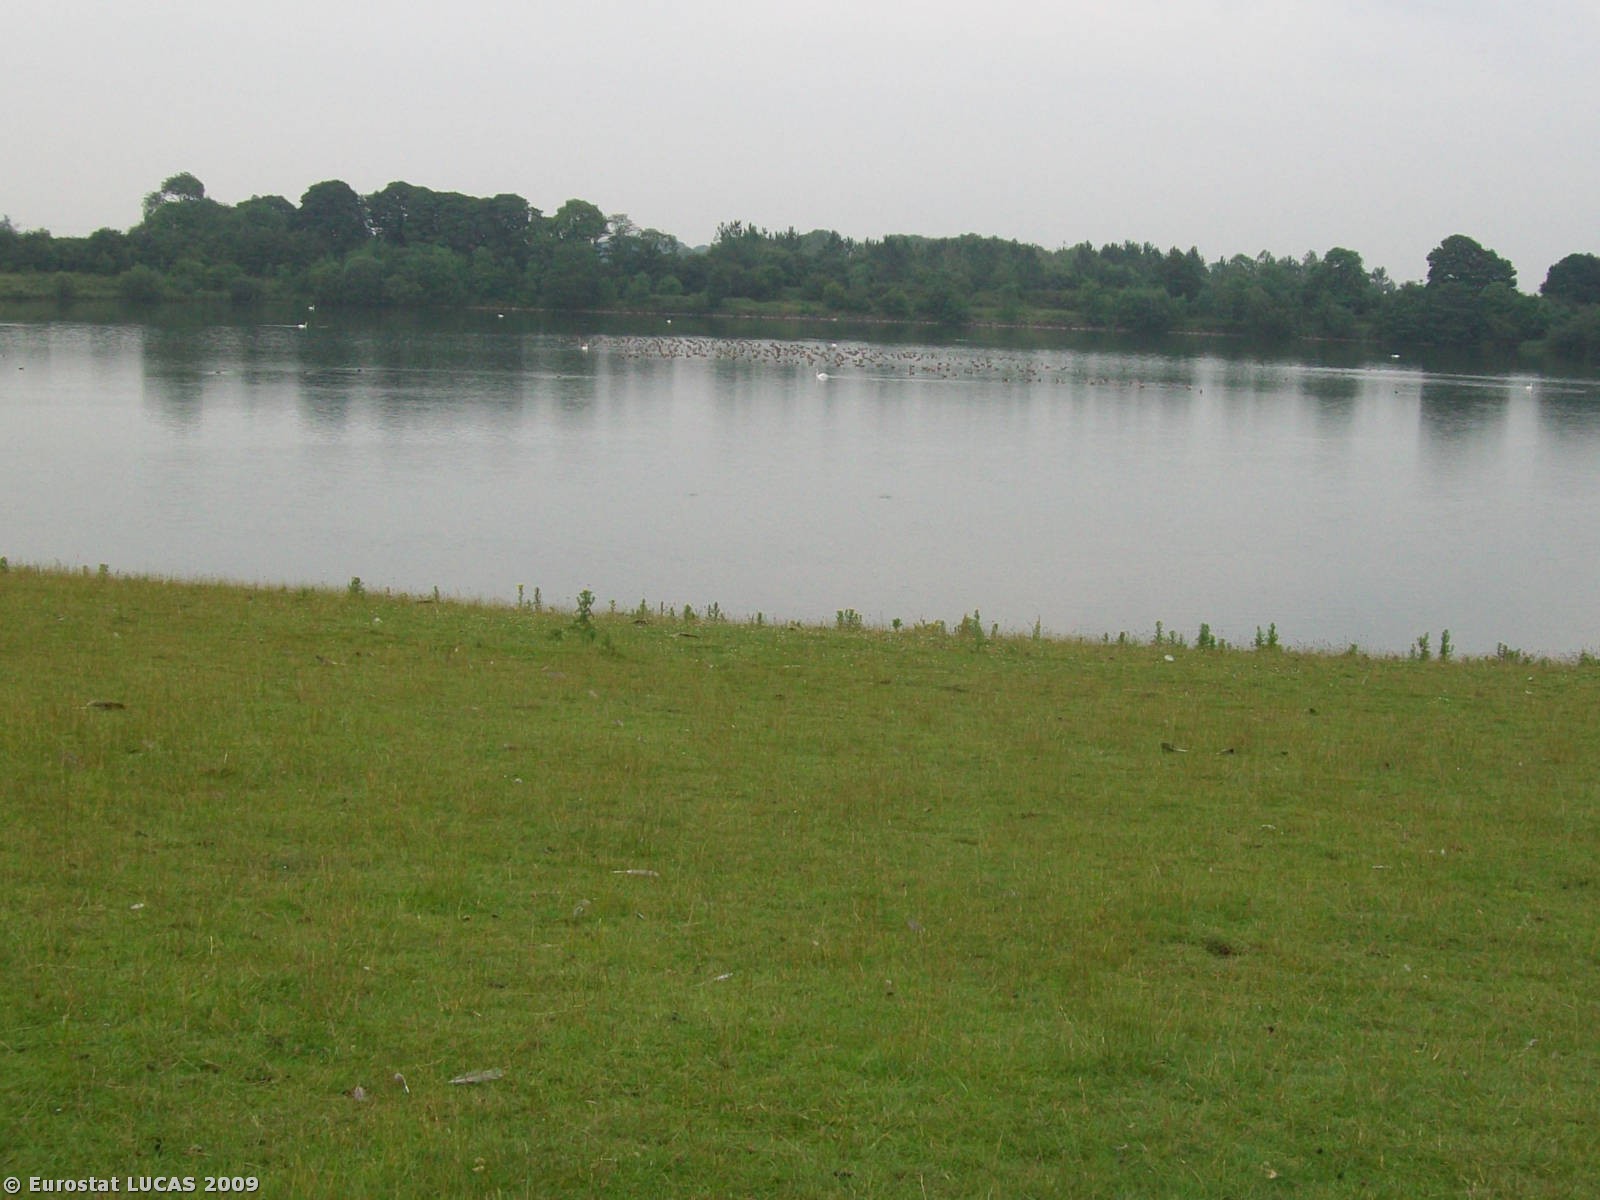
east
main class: Grassland
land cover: Grassland without tree/shrub cover
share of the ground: < 10 %
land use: Agriculture (excluding fallow land and kitchen gardens)
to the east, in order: Grassland without tree/shrub cover; Inland water bodies
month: June
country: GB
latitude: 54.0195
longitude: -1.4499
